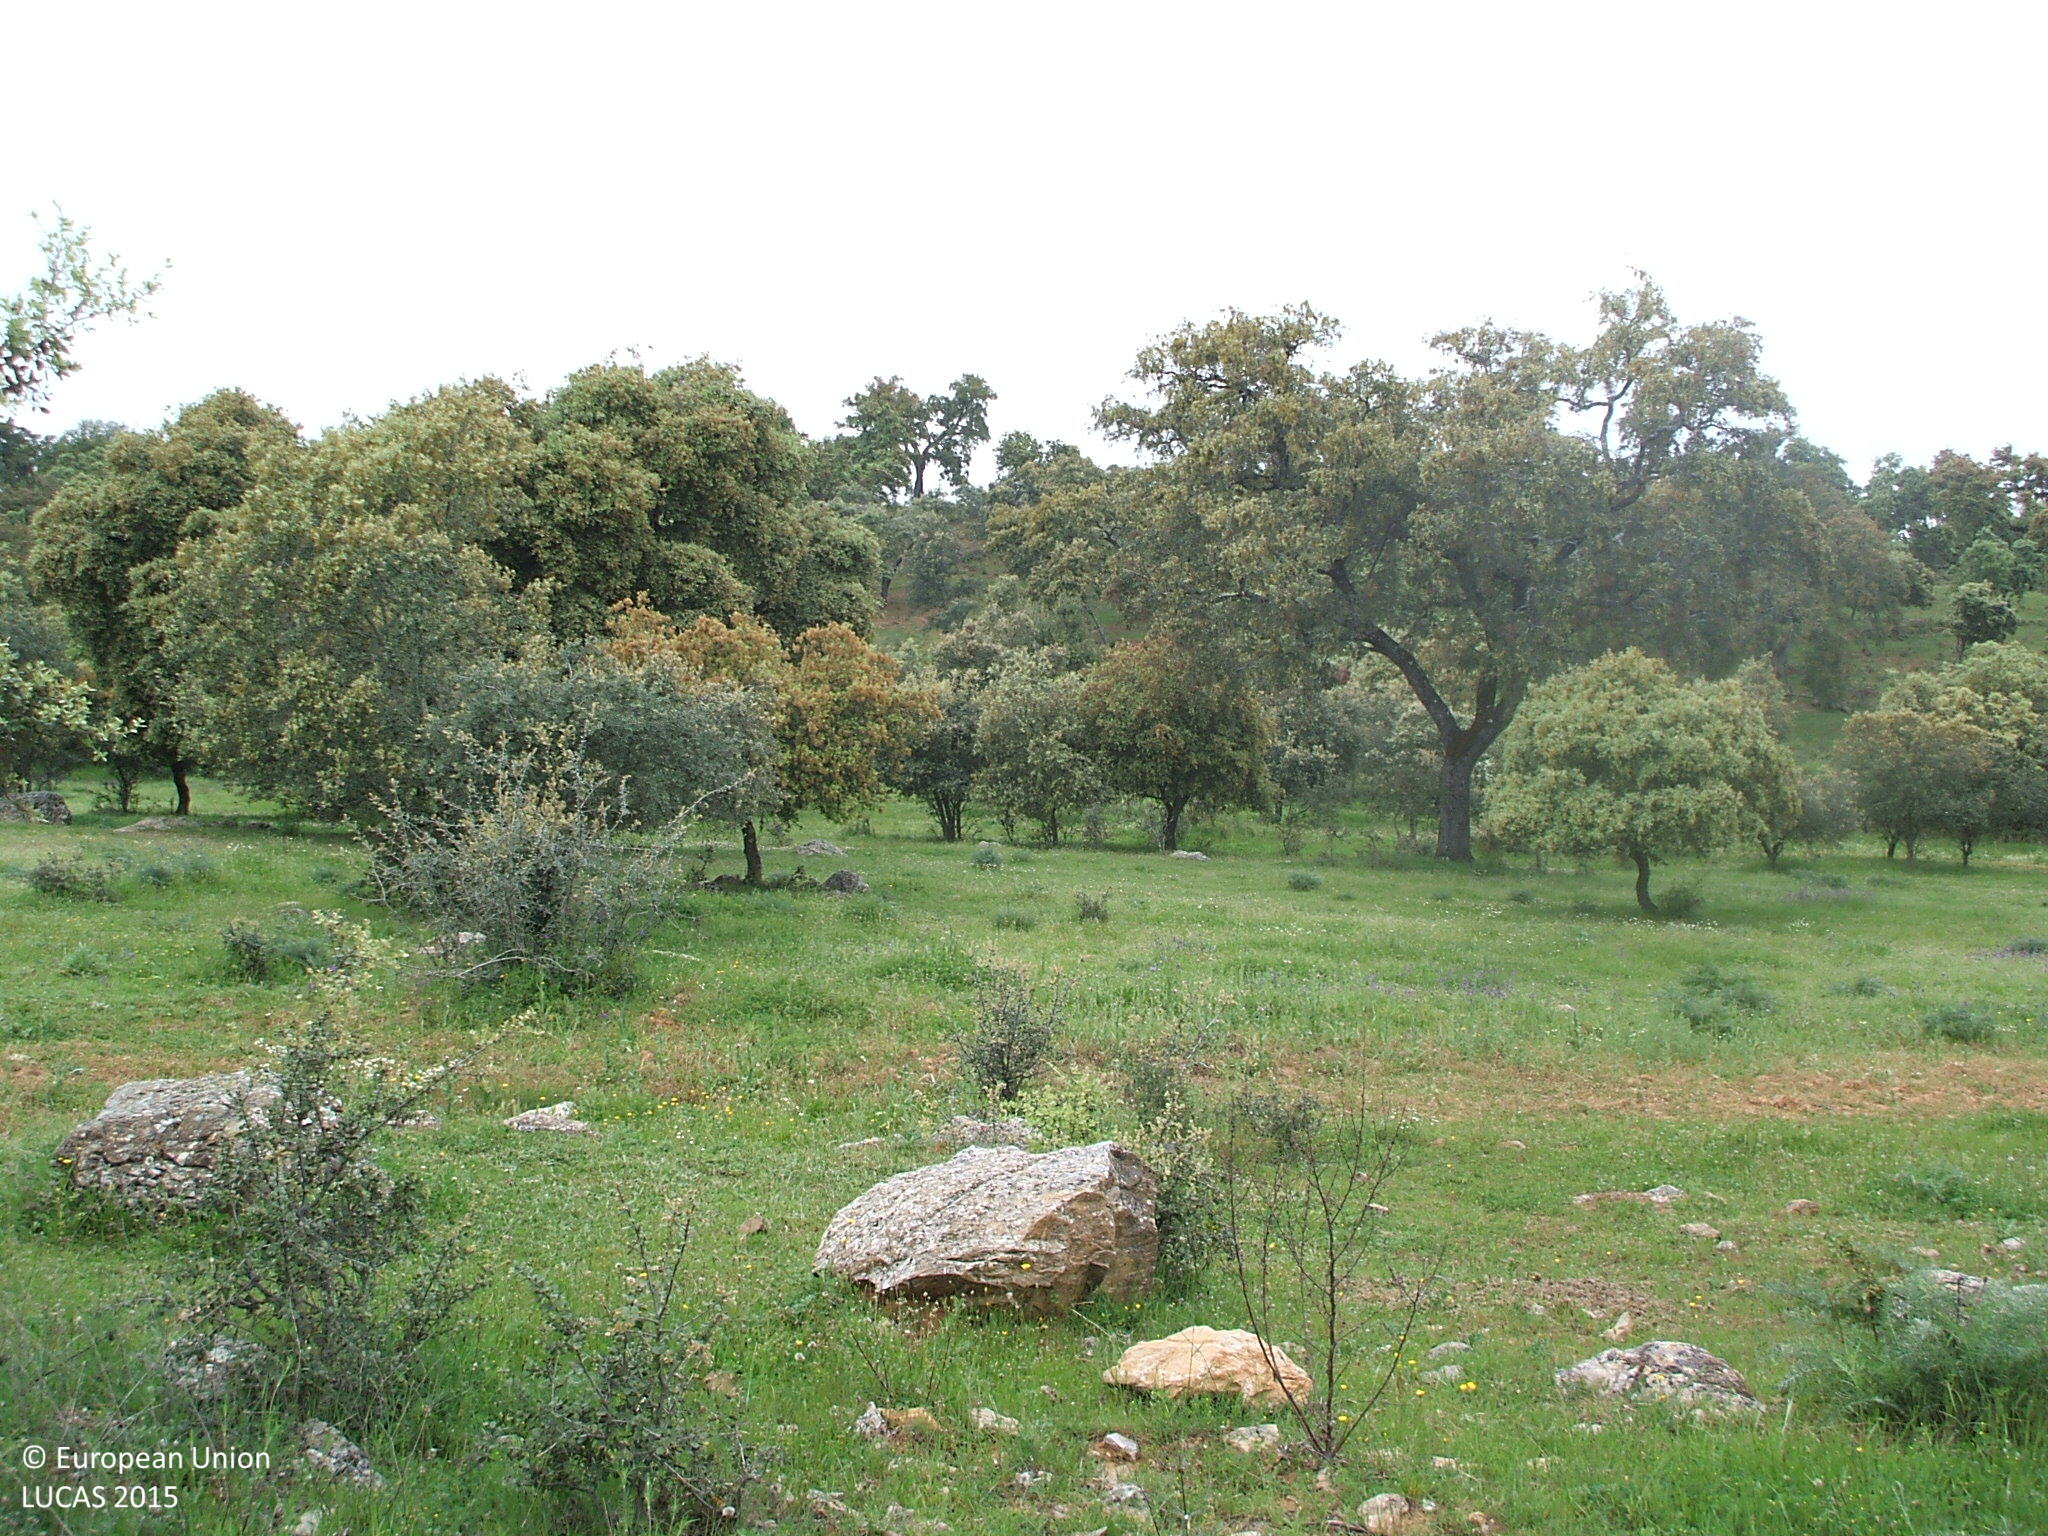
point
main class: Woodland
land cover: Broadleaved woodland
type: broadleaved evergreen forest
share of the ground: 10 - 25 %
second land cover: Grassland without tree/shrub cover
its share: > 75 %
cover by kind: herbaceous plants 80 %, broadleaved forest trees 20 %
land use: Forestry
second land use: Agriculture (excluding fallow land and kitchen gardens)
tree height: > 5 m
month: April
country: ES
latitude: 38.0416
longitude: -5.6750
